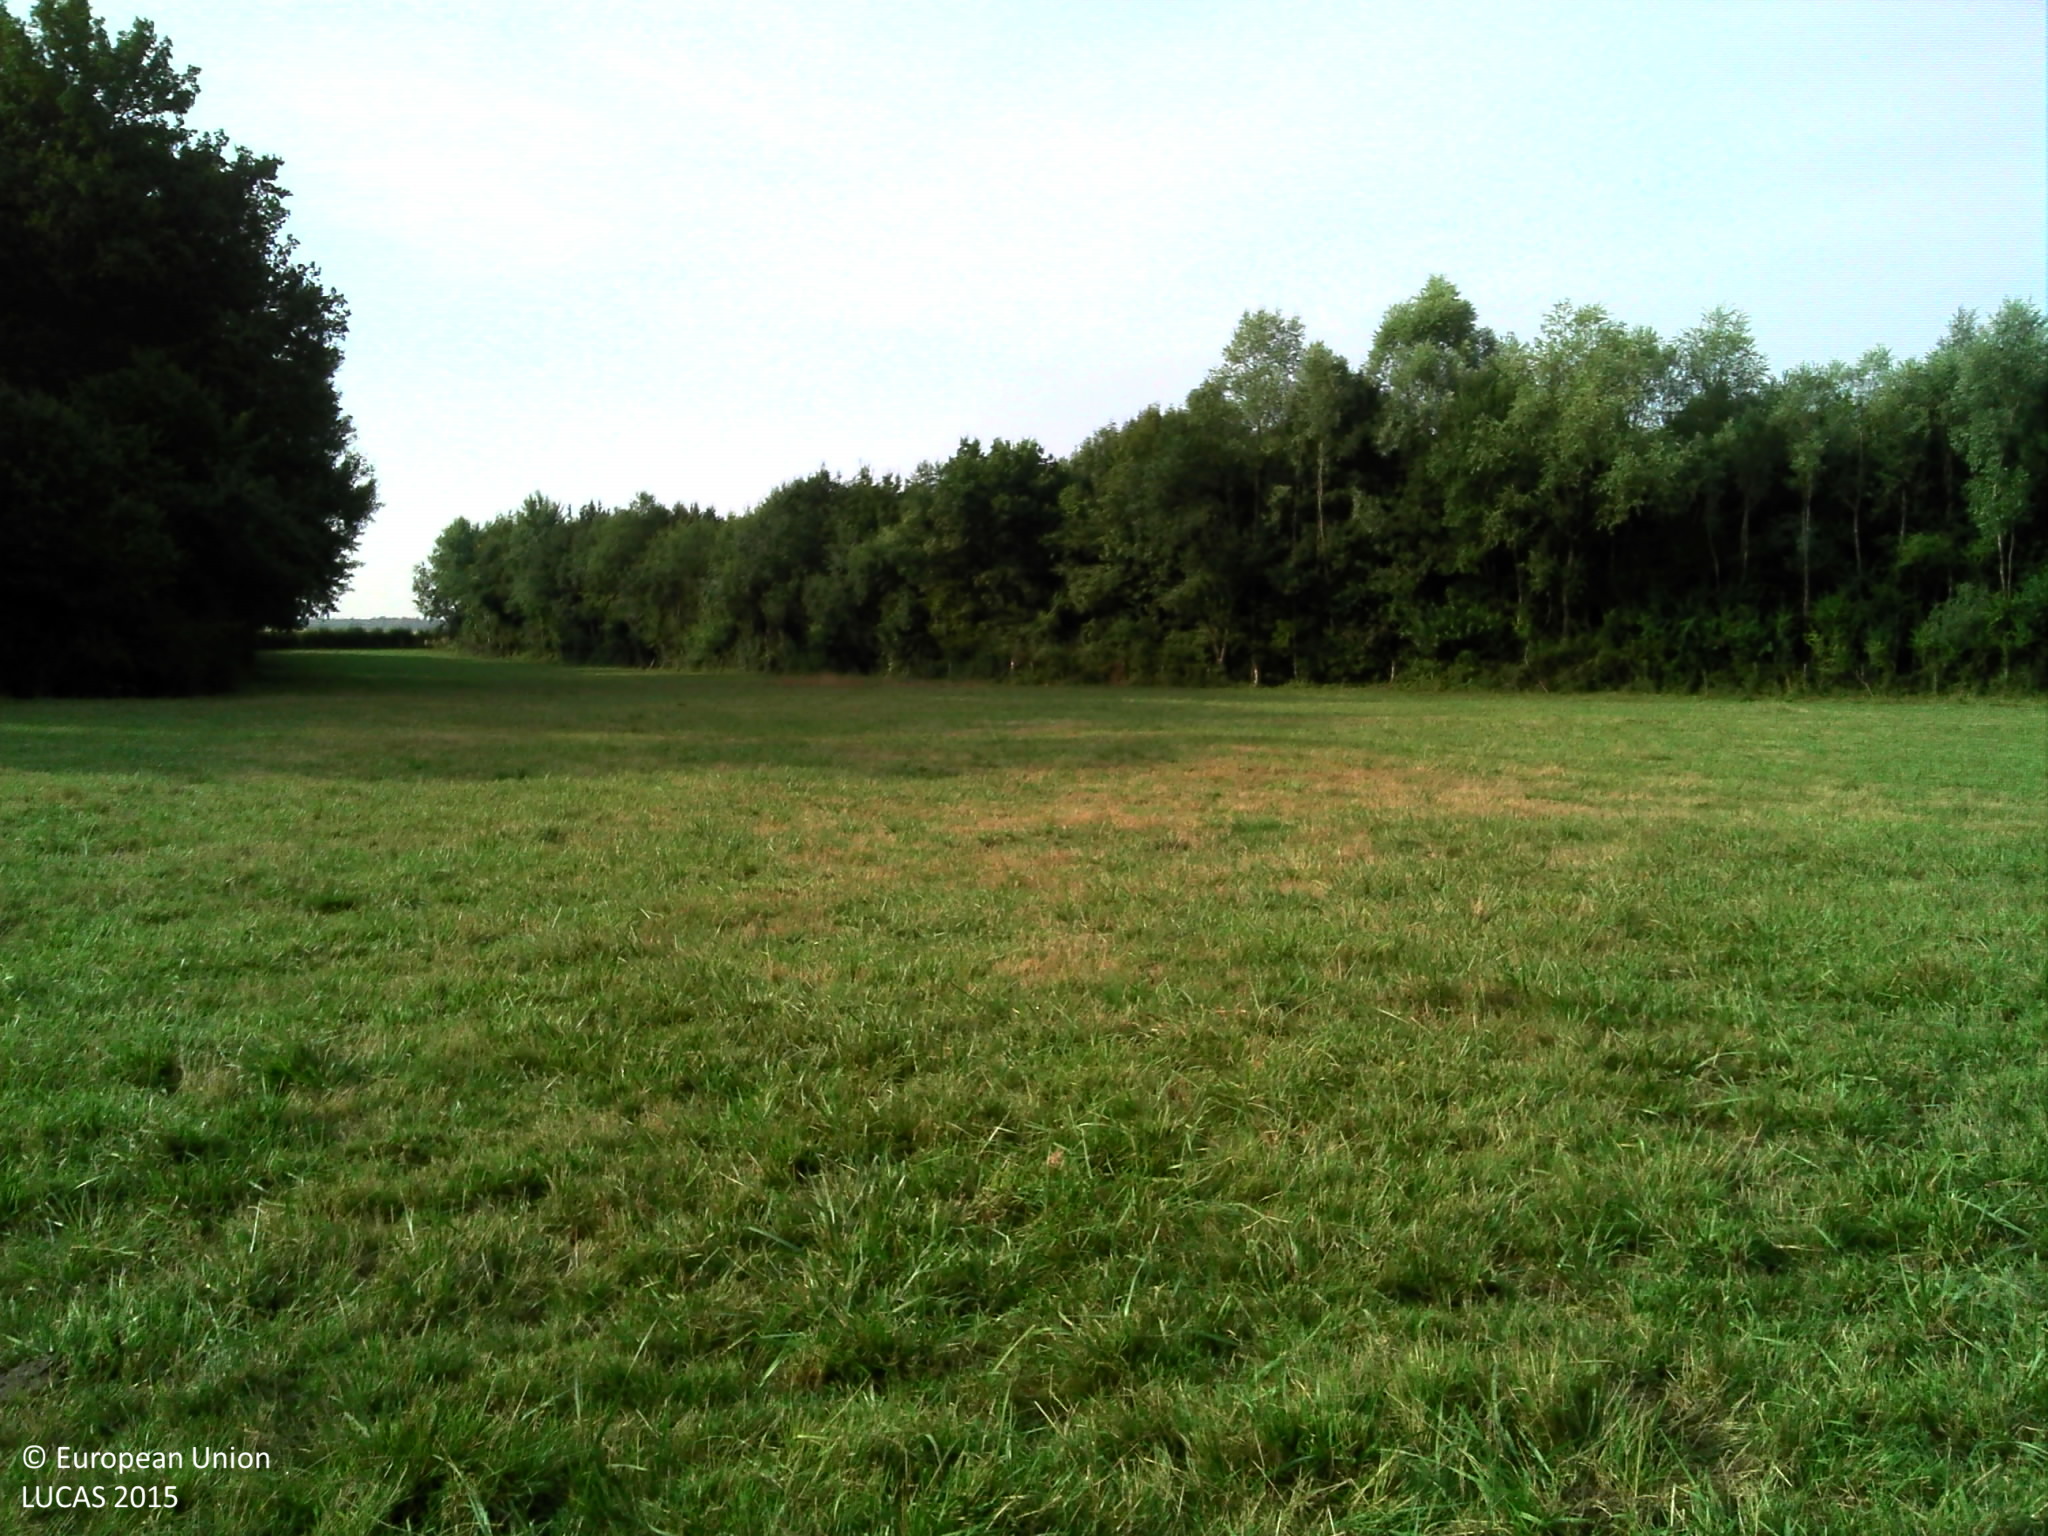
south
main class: Grassland
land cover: Grassland without tree/shrub cover
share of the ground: > 75 %
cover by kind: herbaceous plants 100 %
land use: Agriculture (excluding fallow land and kitchen gardens)
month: August
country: FR
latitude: 47.8426
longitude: 4.3190
